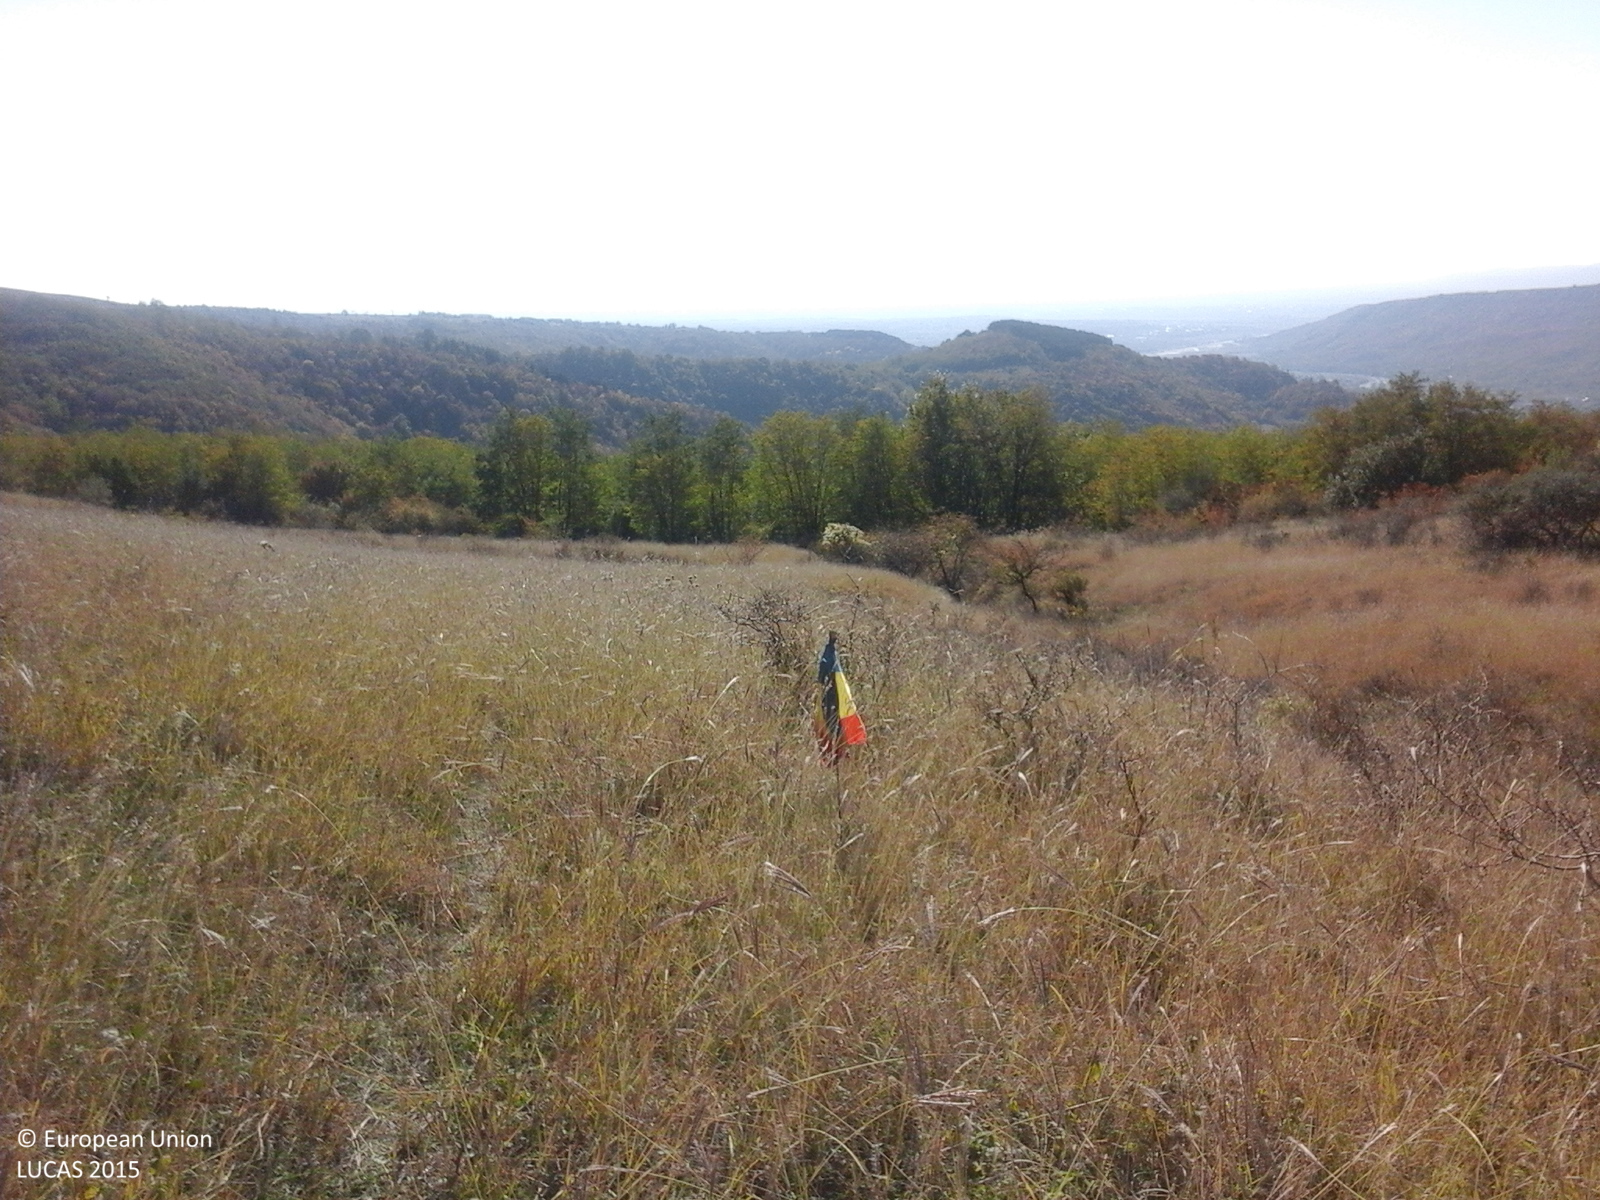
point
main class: Grassland
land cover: Grassland with sparse tree/shrub cover
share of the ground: > 75 %
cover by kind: herbaceous plants 95 %, broadleaved forest trees 5 %
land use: Agriculture (excluding fallow land and kitchen gardens)
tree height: > 5 m
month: October
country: RO
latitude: 45.2908
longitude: 26.7702
